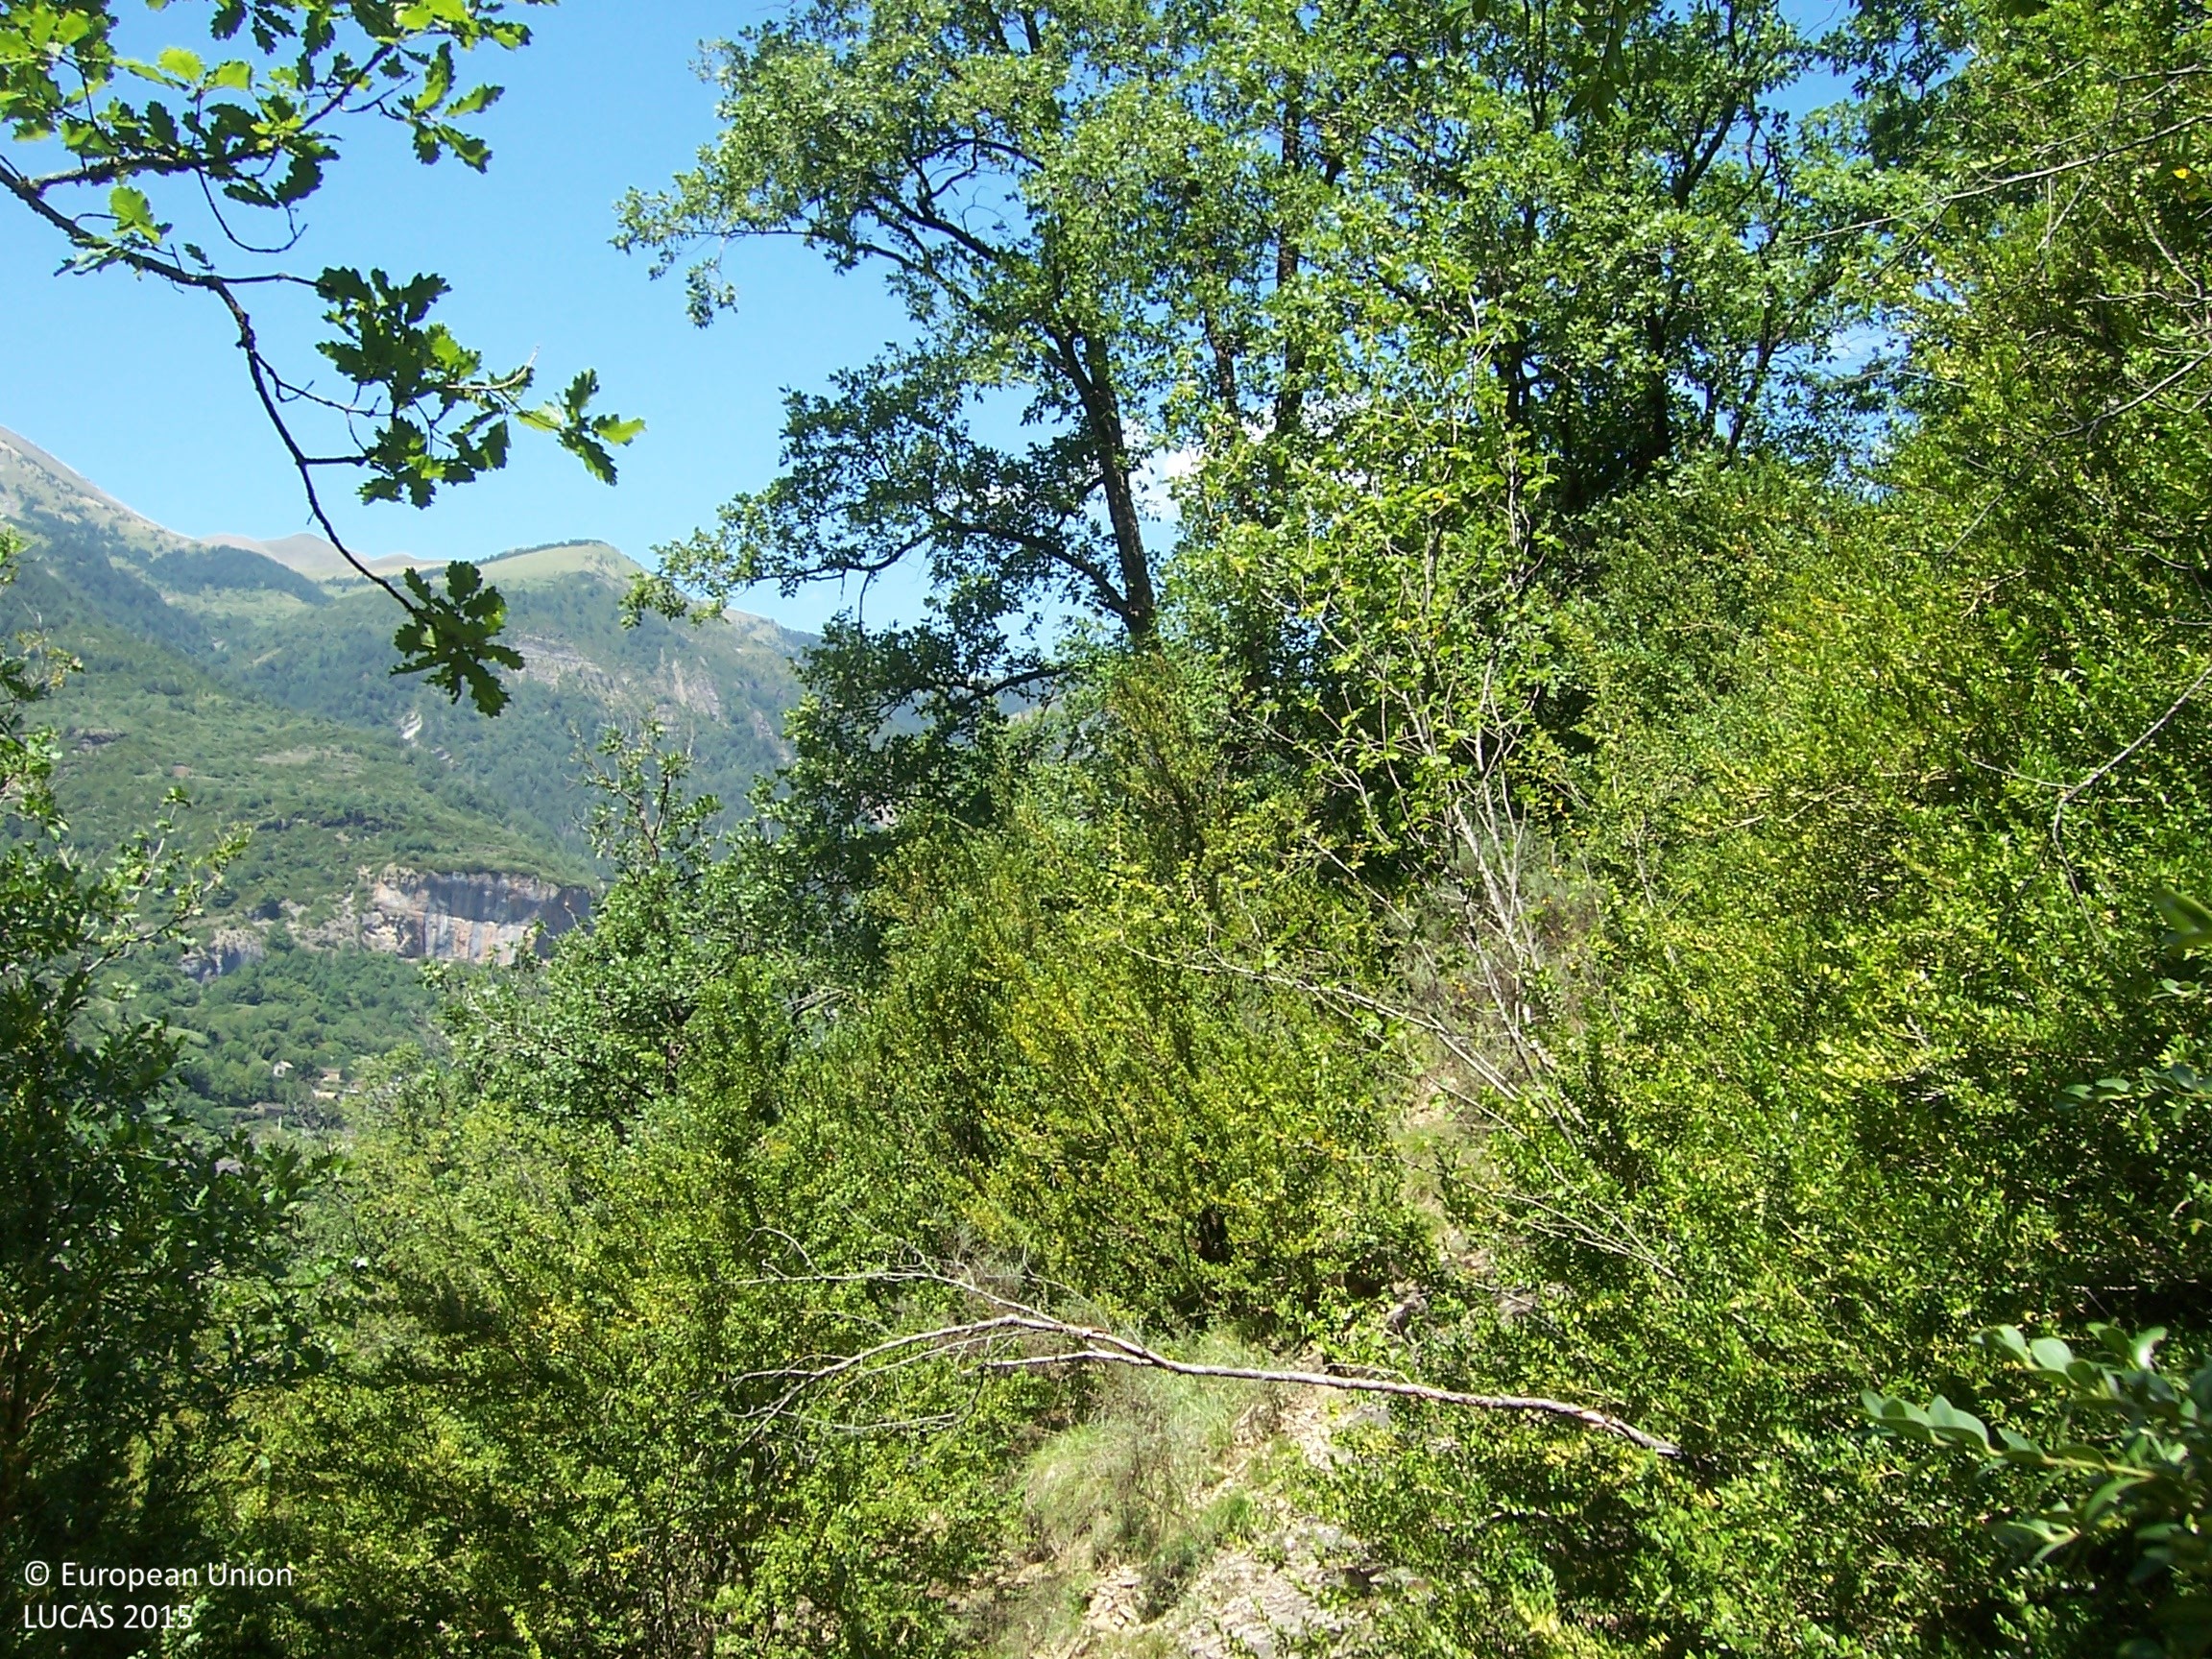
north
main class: Woodland
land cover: Broadleaved woodland
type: mountainous beech forest
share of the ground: > 75 %
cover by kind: broadleaved forest trees 100 %
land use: Semi-natural and natural areas not in use
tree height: > 5 m
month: August
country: ES
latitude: 42.6200
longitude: -0.1070
